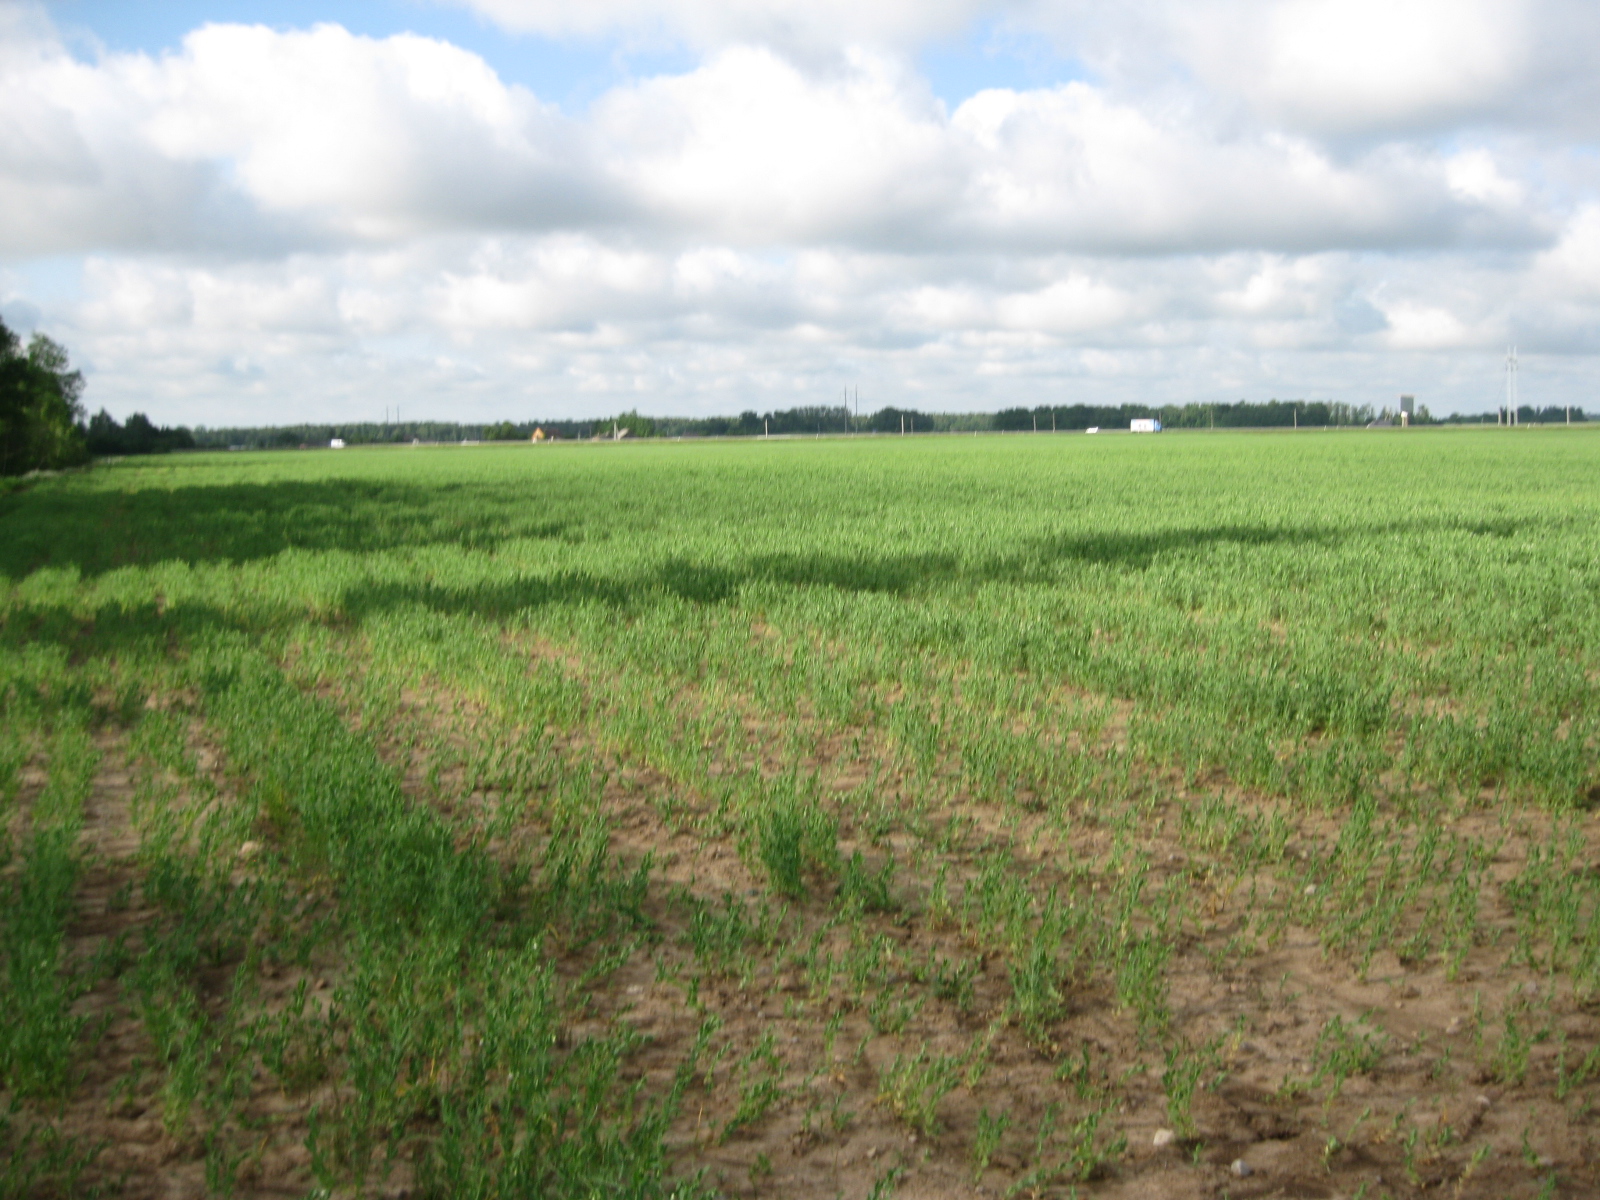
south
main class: Cropland
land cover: Dry pulses
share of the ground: 25 - 50 %
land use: Agriculture (excluding fallow land and kitchen gardens)
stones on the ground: < 10 %
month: June
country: LT
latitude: 55.1780
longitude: 23.6662
